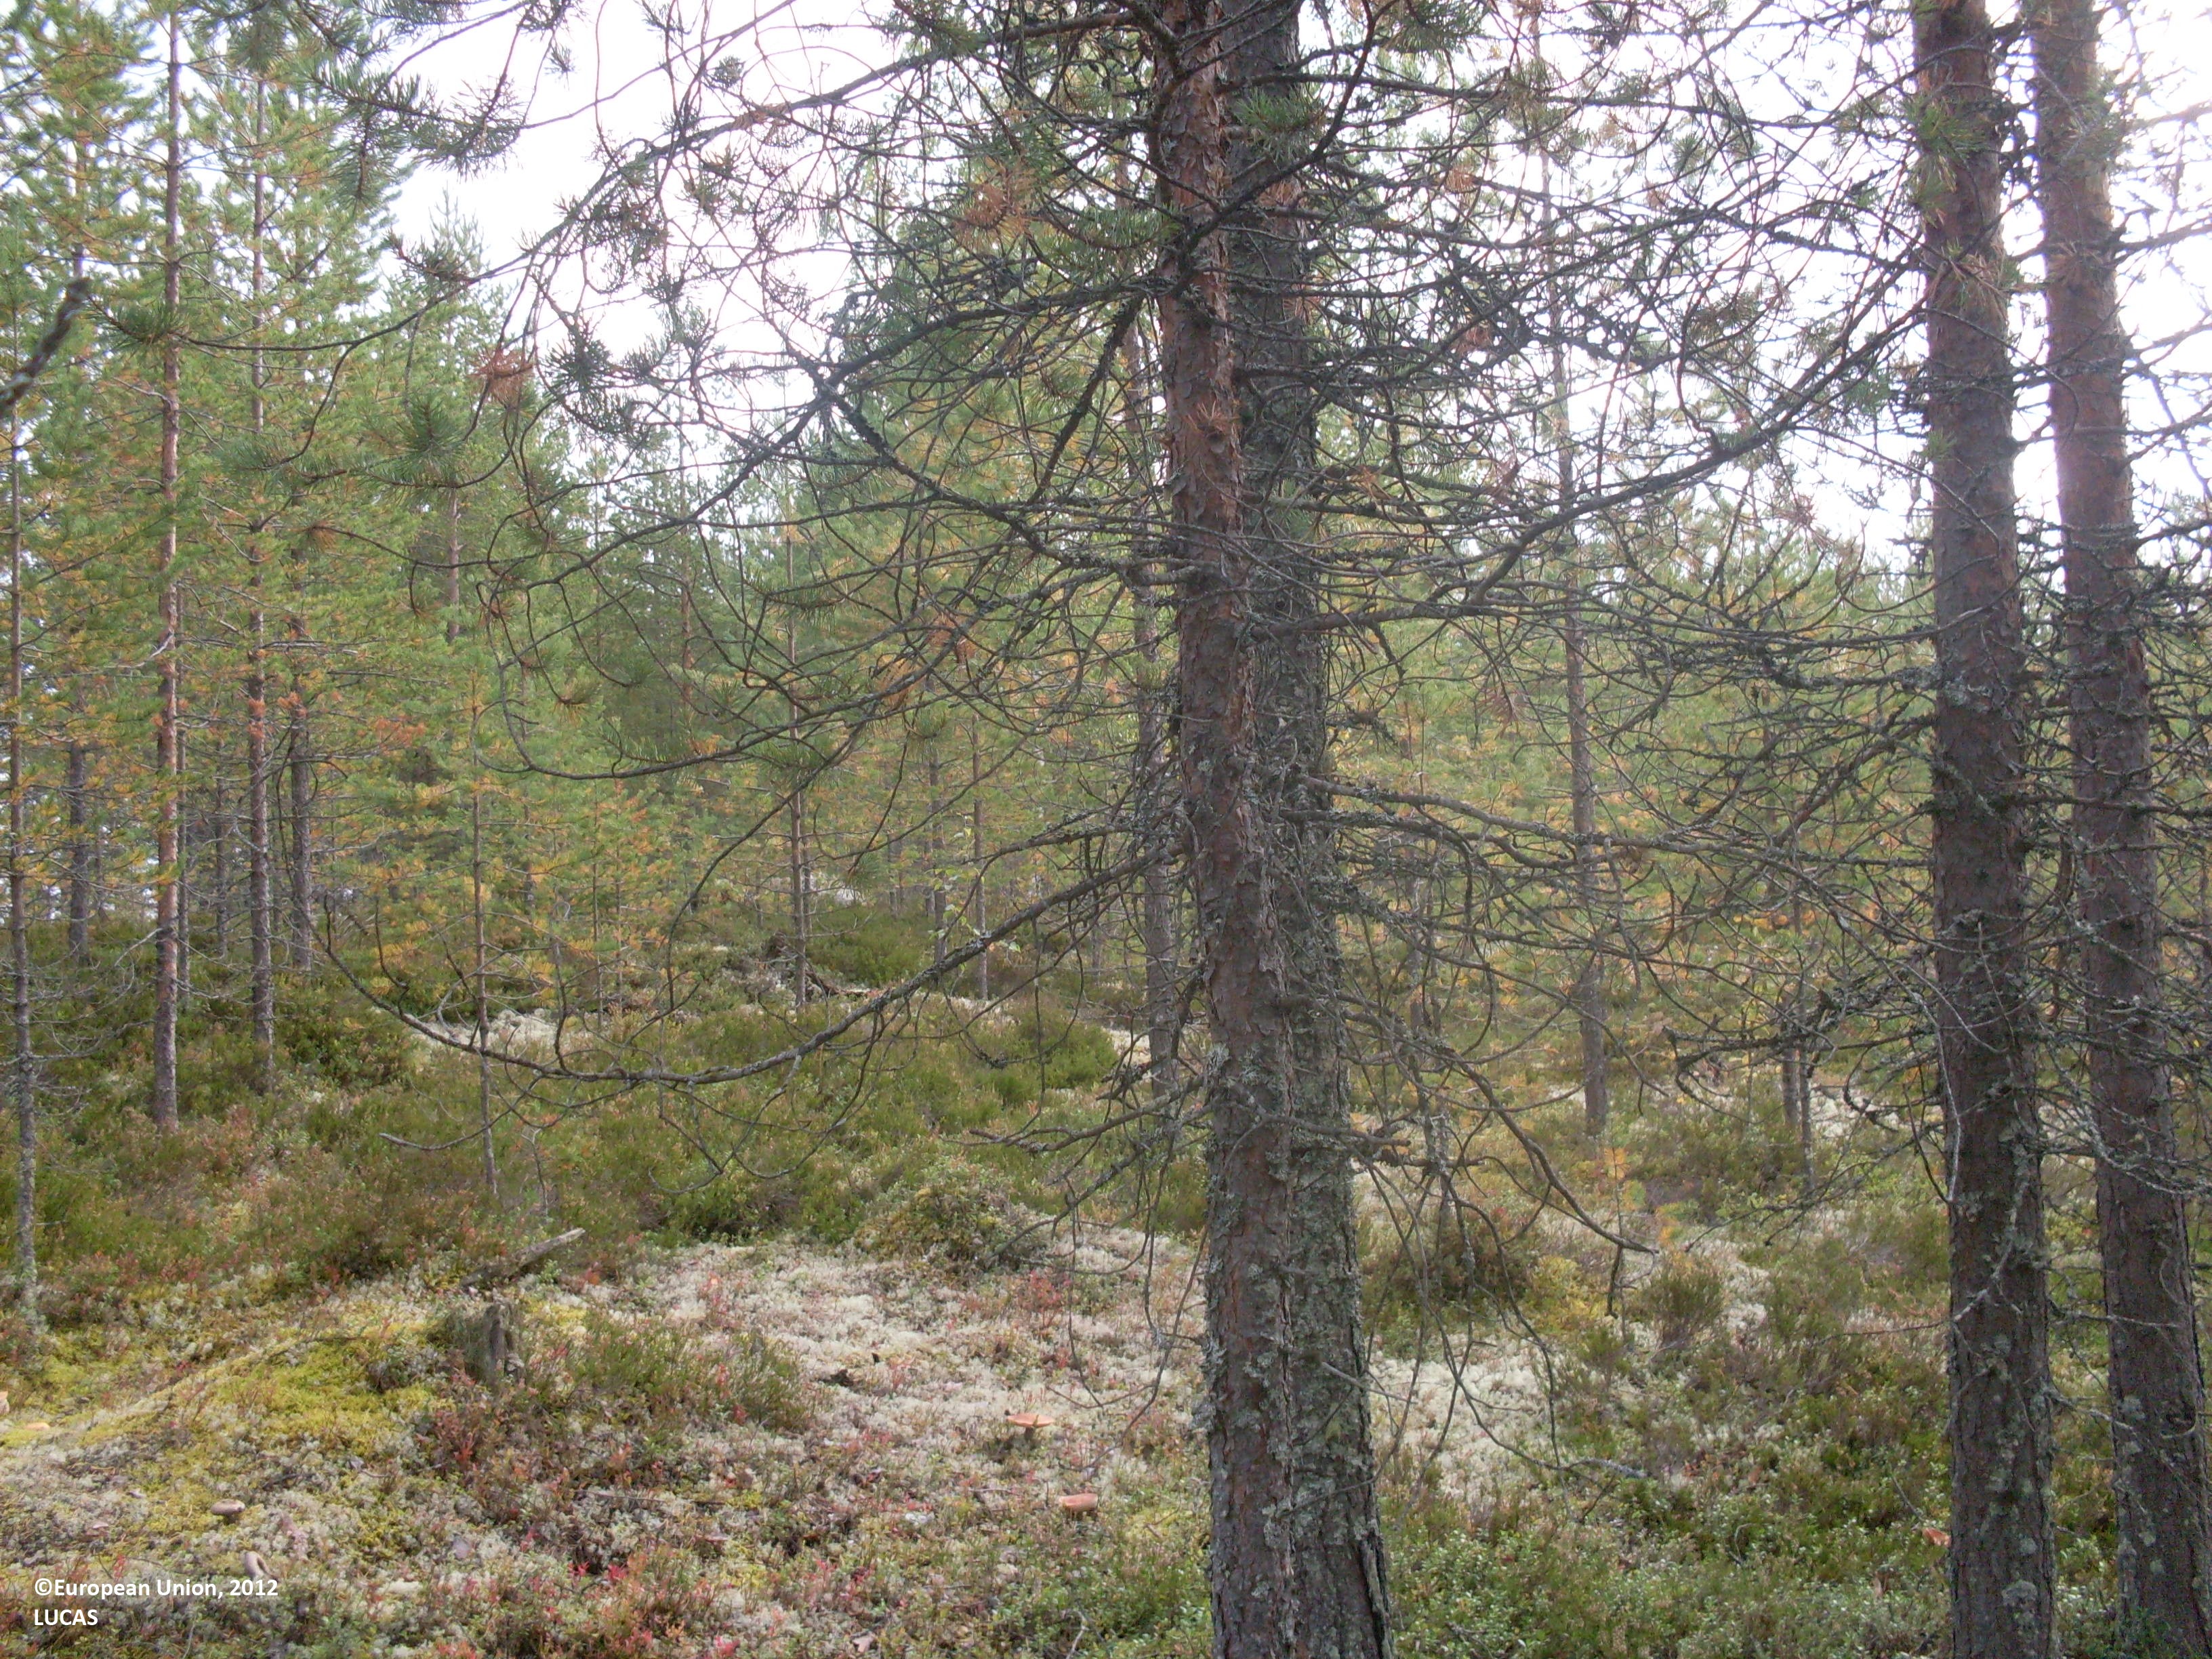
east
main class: Woodland
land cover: Pine dominated coniferous woodland
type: boreal forest
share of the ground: 50 - 75 %
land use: Forestry
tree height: > 5 m
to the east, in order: Pine dominated coniferous woodland
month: September
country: FI
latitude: 64.0789
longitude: 29.5566
